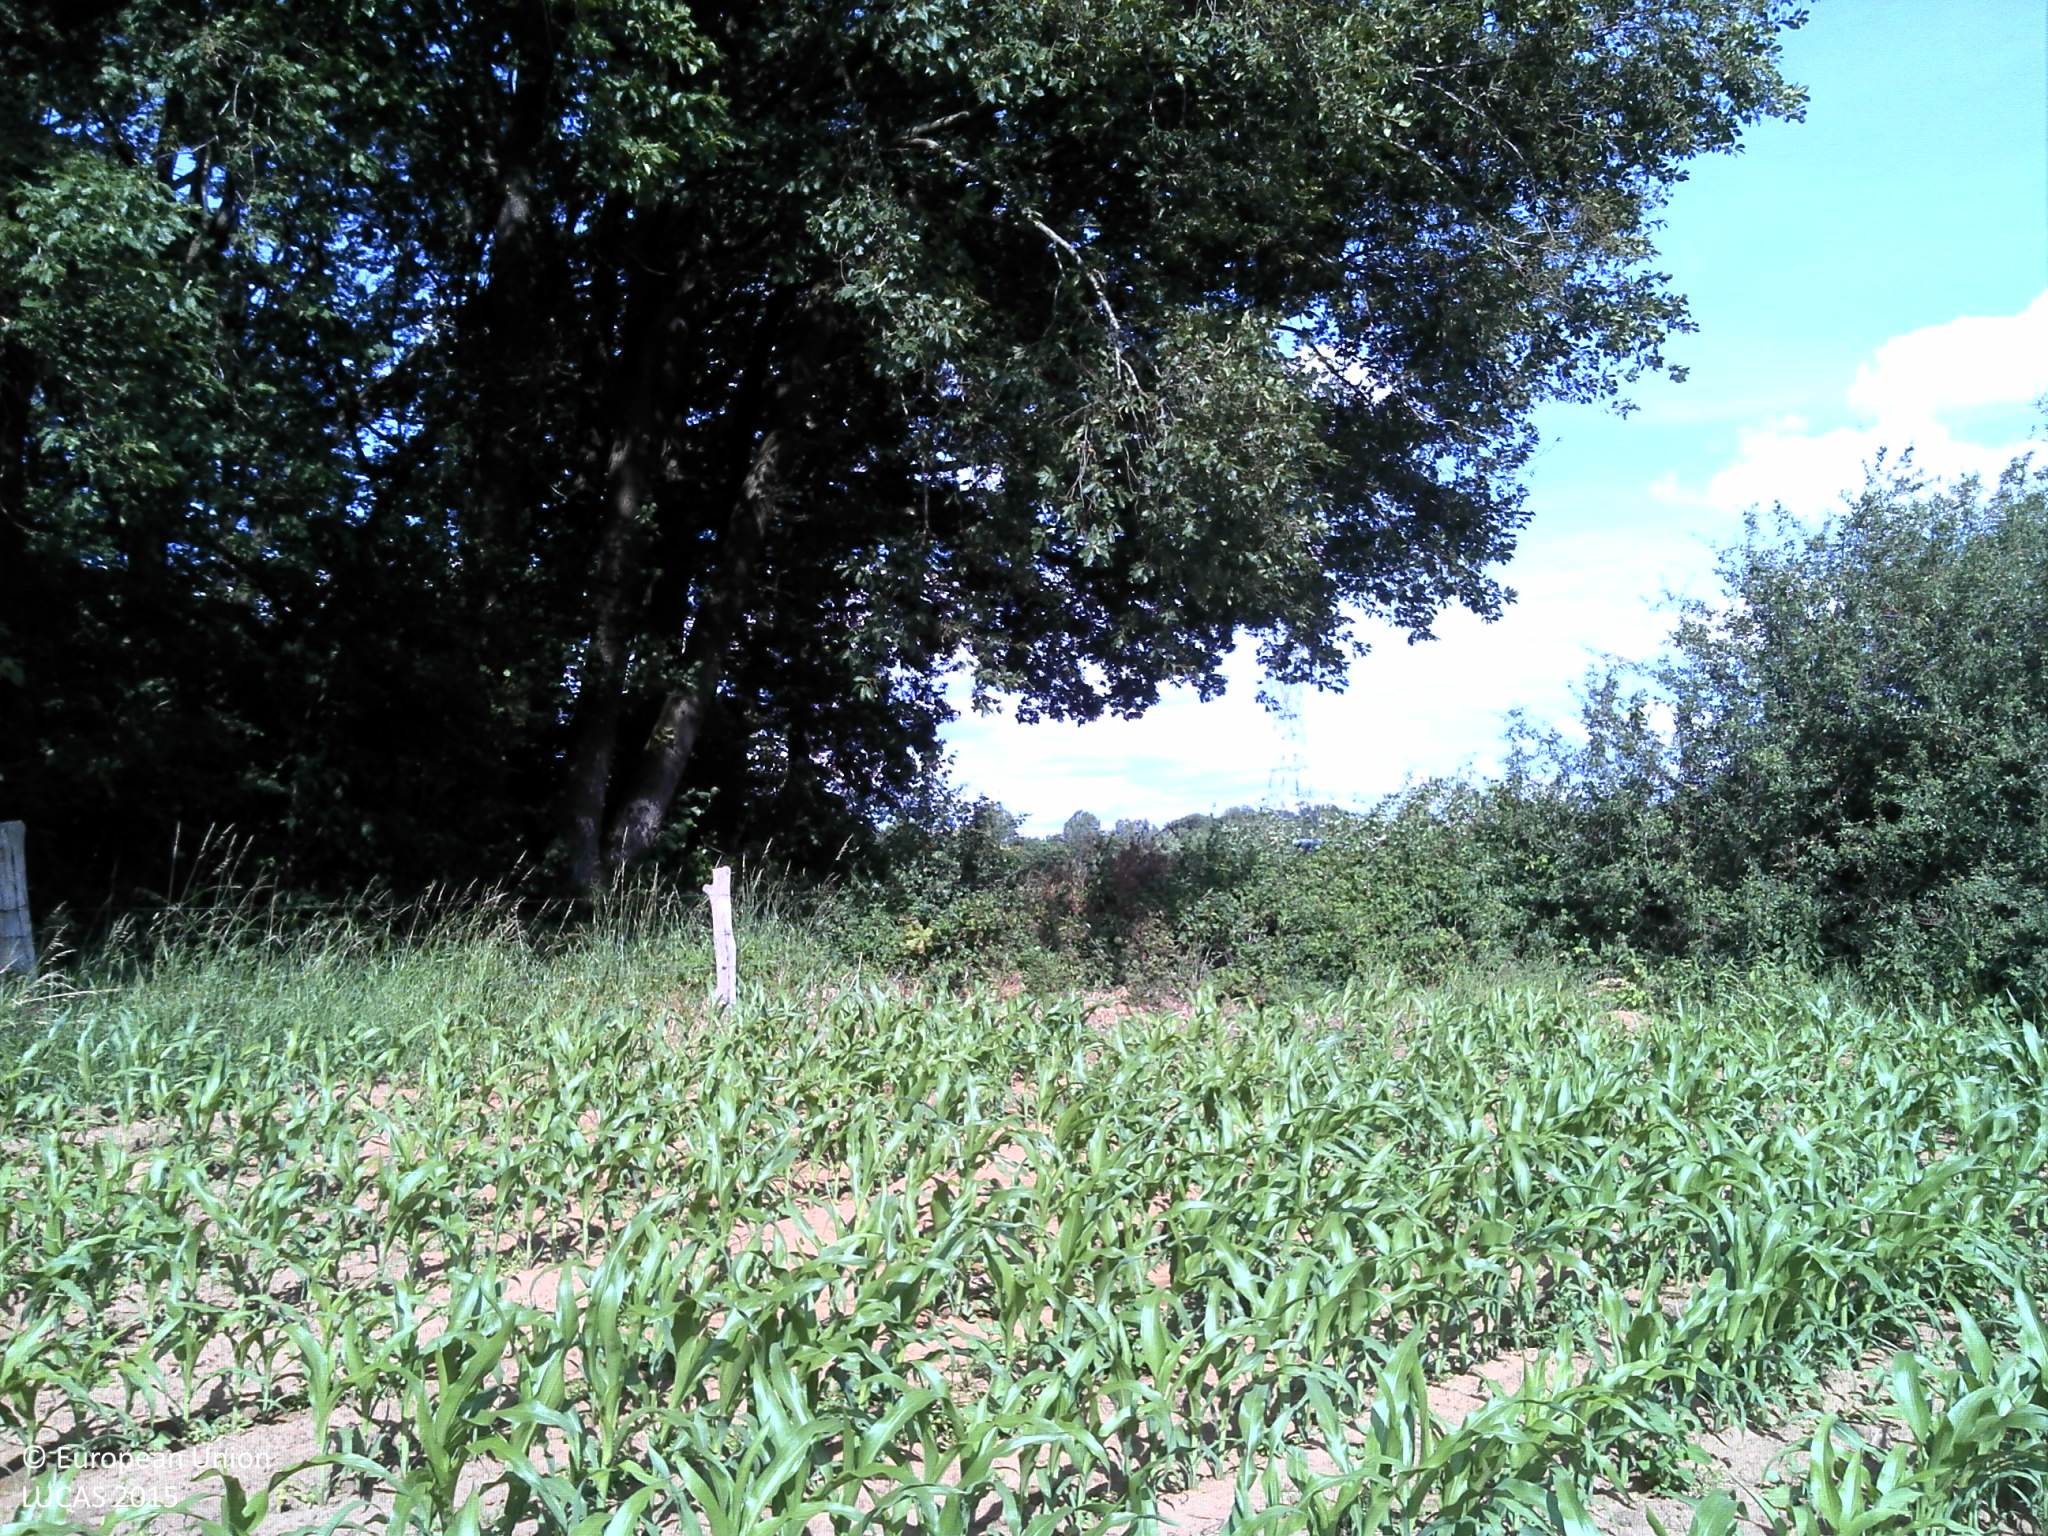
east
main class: Cropland
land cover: Maize
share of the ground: 25 - 50 %
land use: Agriculture (excluding fallow land and kitchen gardens)
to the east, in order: Maize; Abandoned hedges; Fences; Tracks; Maize; Grass margins; Tracks; Grass margins; Grassland without tree/shrub cover; Electric lines; Grassland without tree/shrub cover
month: June
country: FR
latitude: 49.7589
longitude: 4.7913
